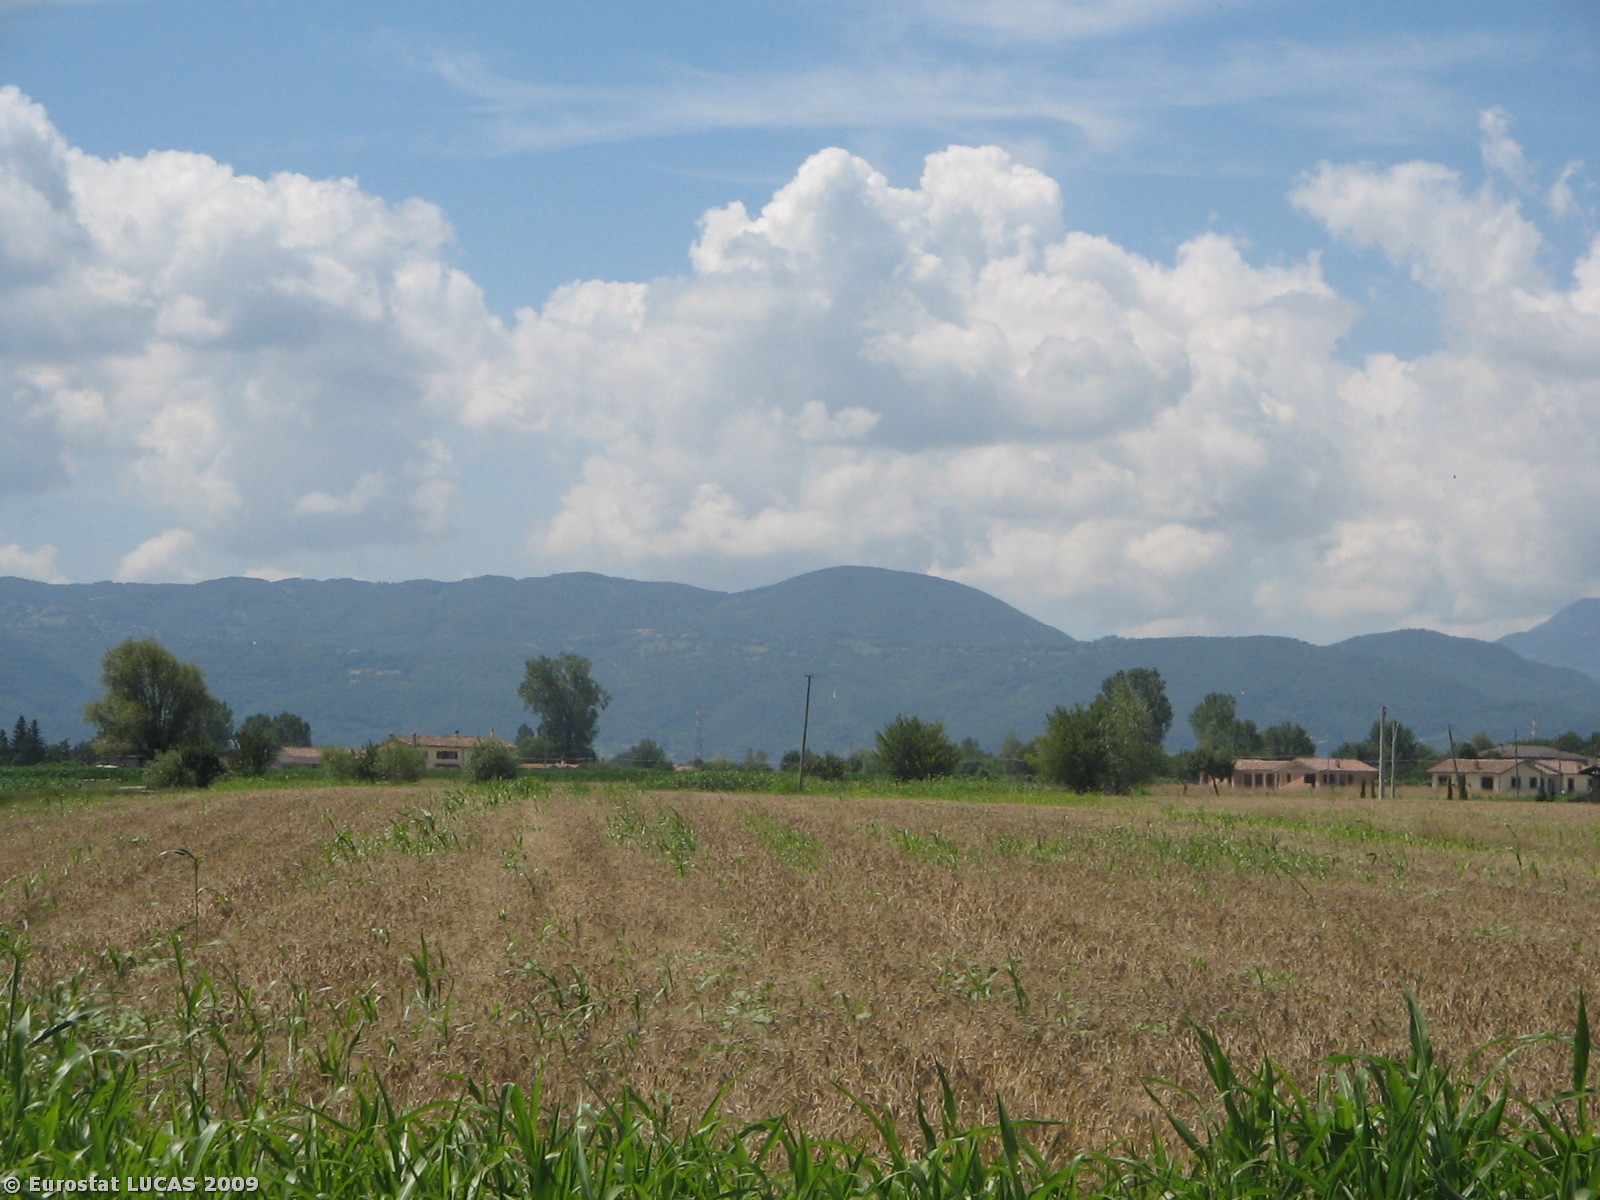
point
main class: Cropland
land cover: Barley
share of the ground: > 75 %
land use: Agriculture (excluding fallow land and kitchen gardens)
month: July
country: IT
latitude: 42.4513
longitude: 12.8481
